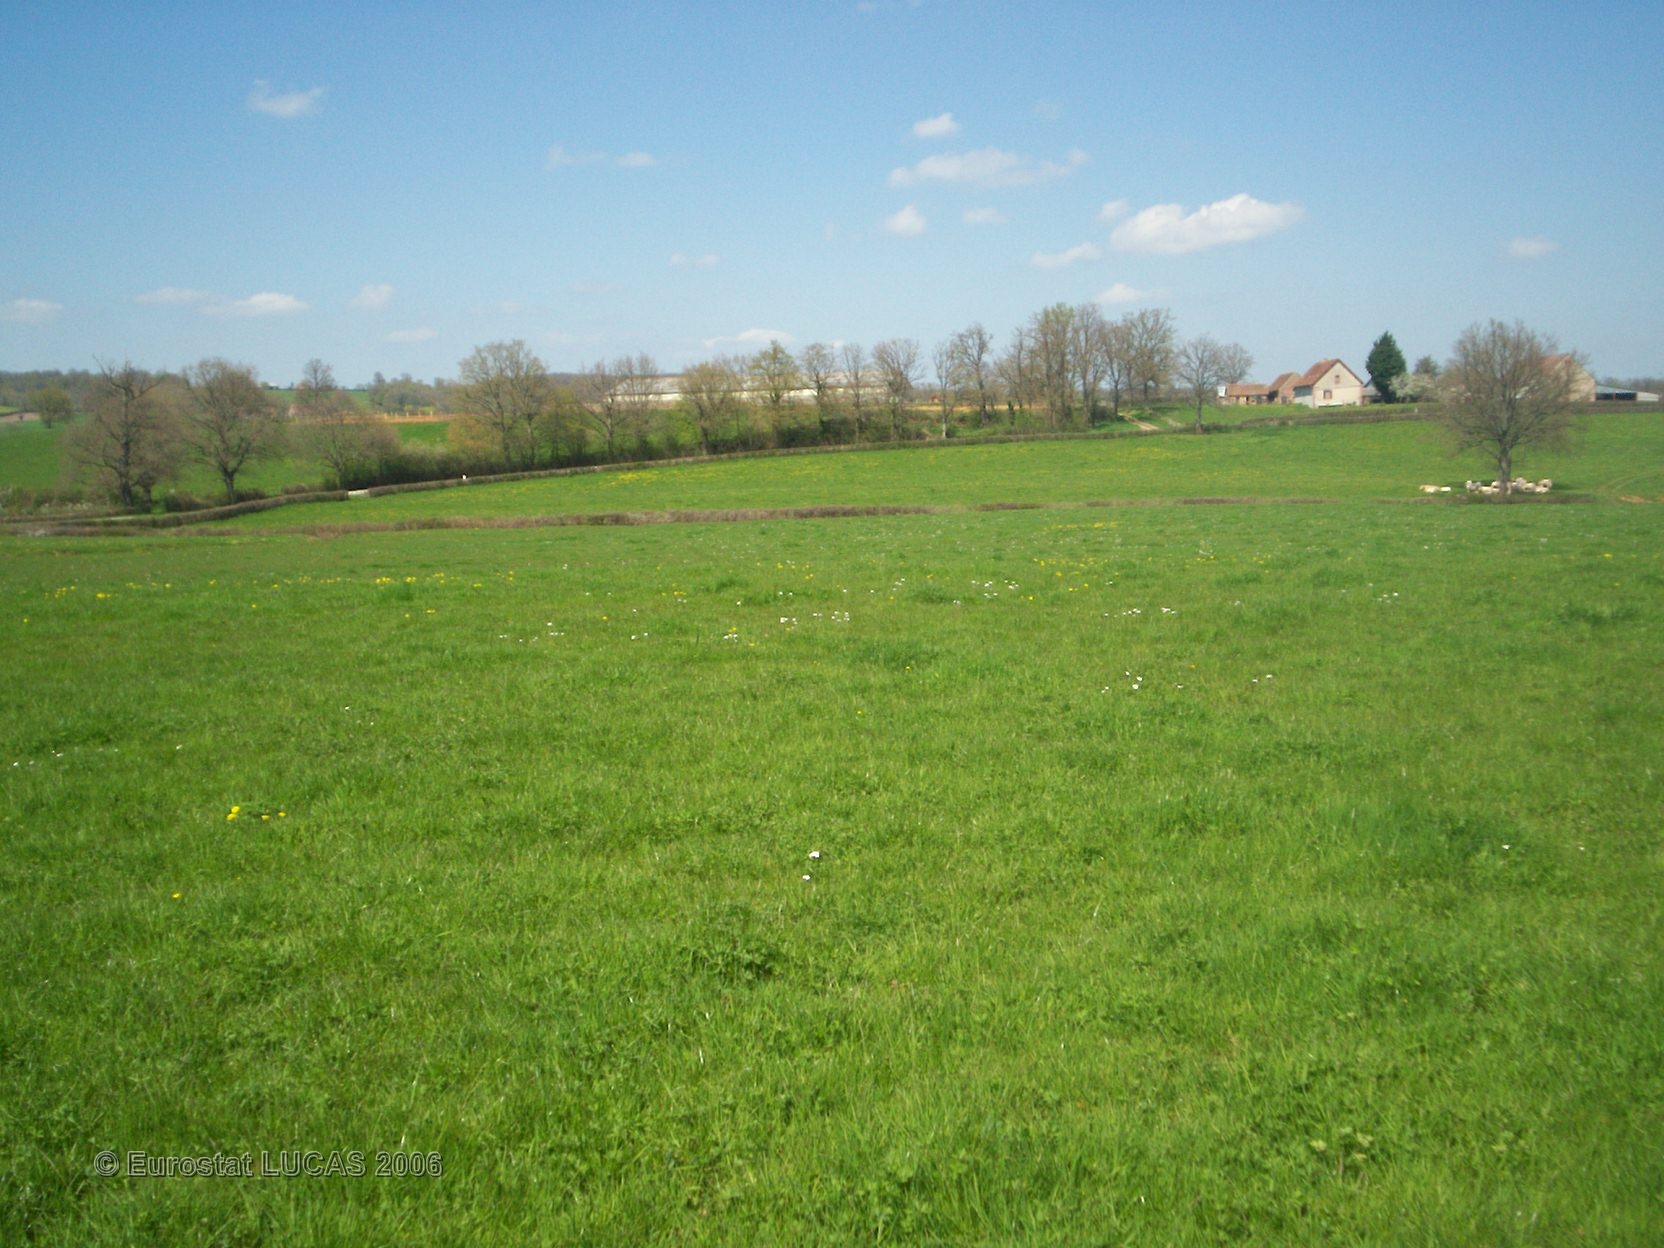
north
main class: Grassland
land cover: Grassland without tree/shrub cover
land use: Agriculture (excluding fallow land and kitchen gardens)
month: April
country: FR
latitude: 46.6514
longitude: 3.0848
